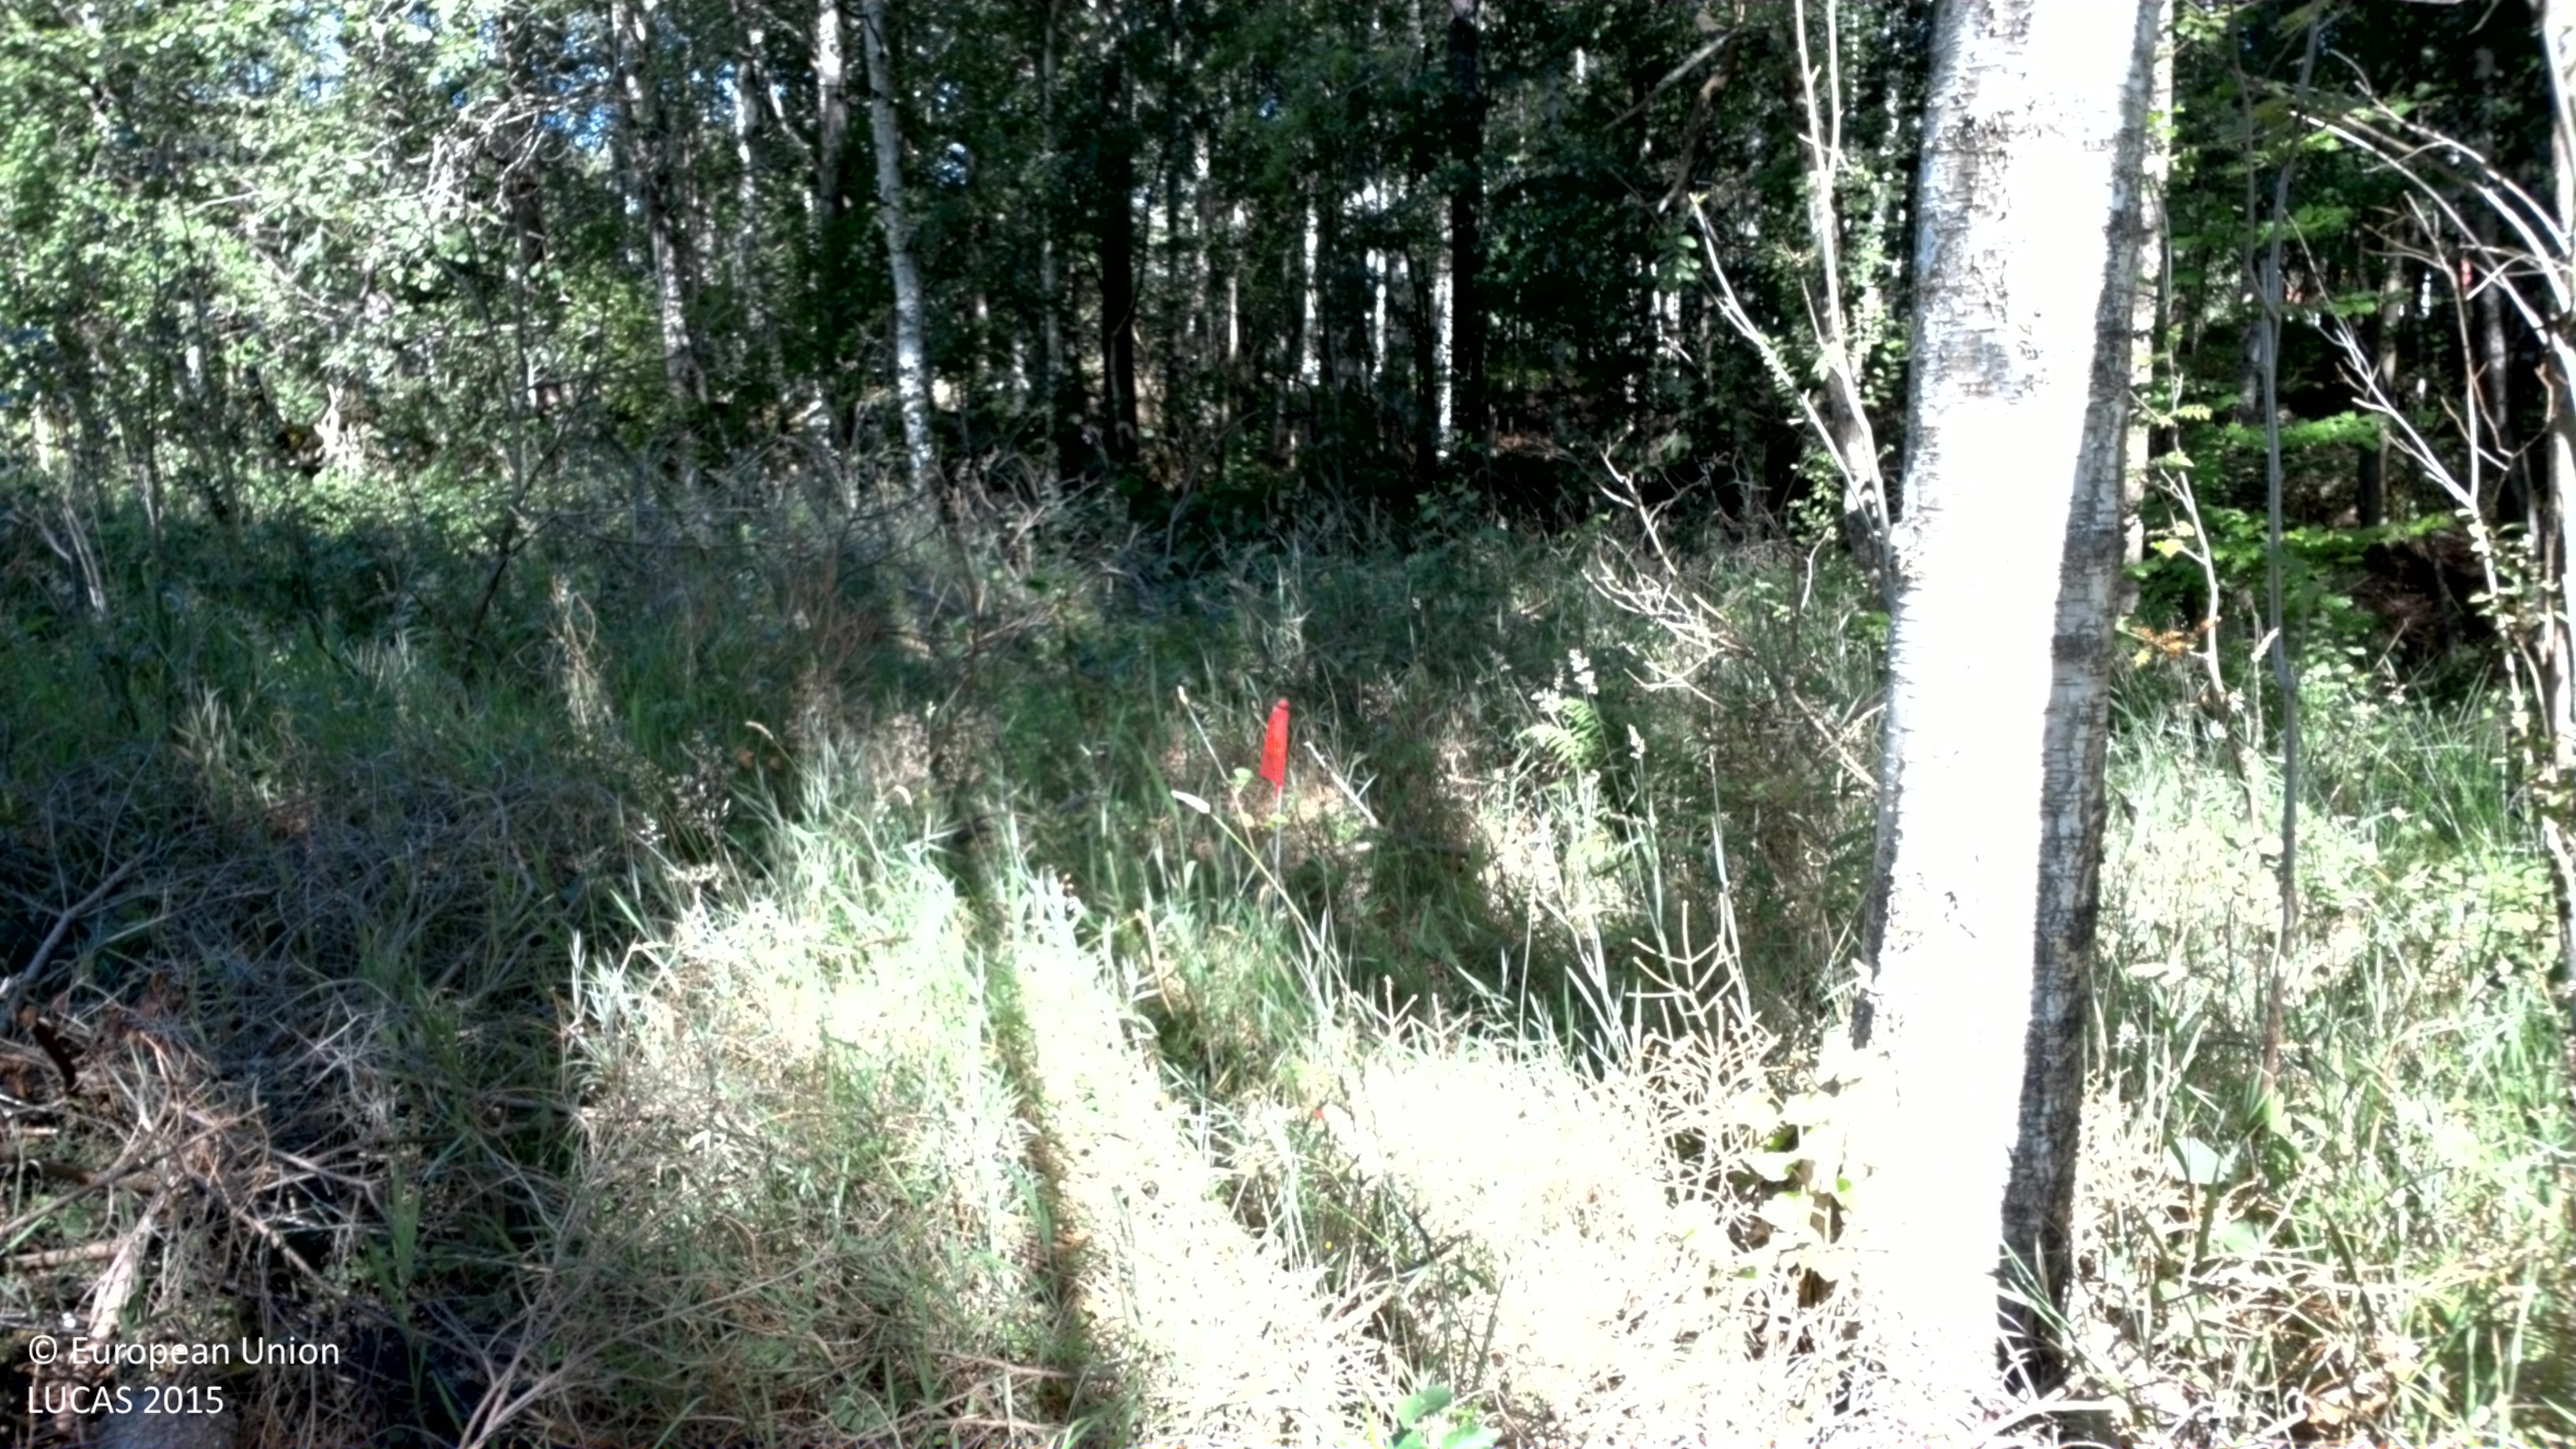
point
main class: Woodland
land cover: Broadleaved woodland
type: hemiboreal forest and nemoral coniferous forest and mixed broadleaved-coniferous forest
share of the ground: 25 - 50 %
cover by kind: herbaceous plants 55 %, broadleaved forest trees 35 %, shrubs 10 %
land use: Forestry
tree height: > 5 m
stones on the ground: < 10 %
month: August
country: SE
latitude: 56.3369
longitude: 14.6728
